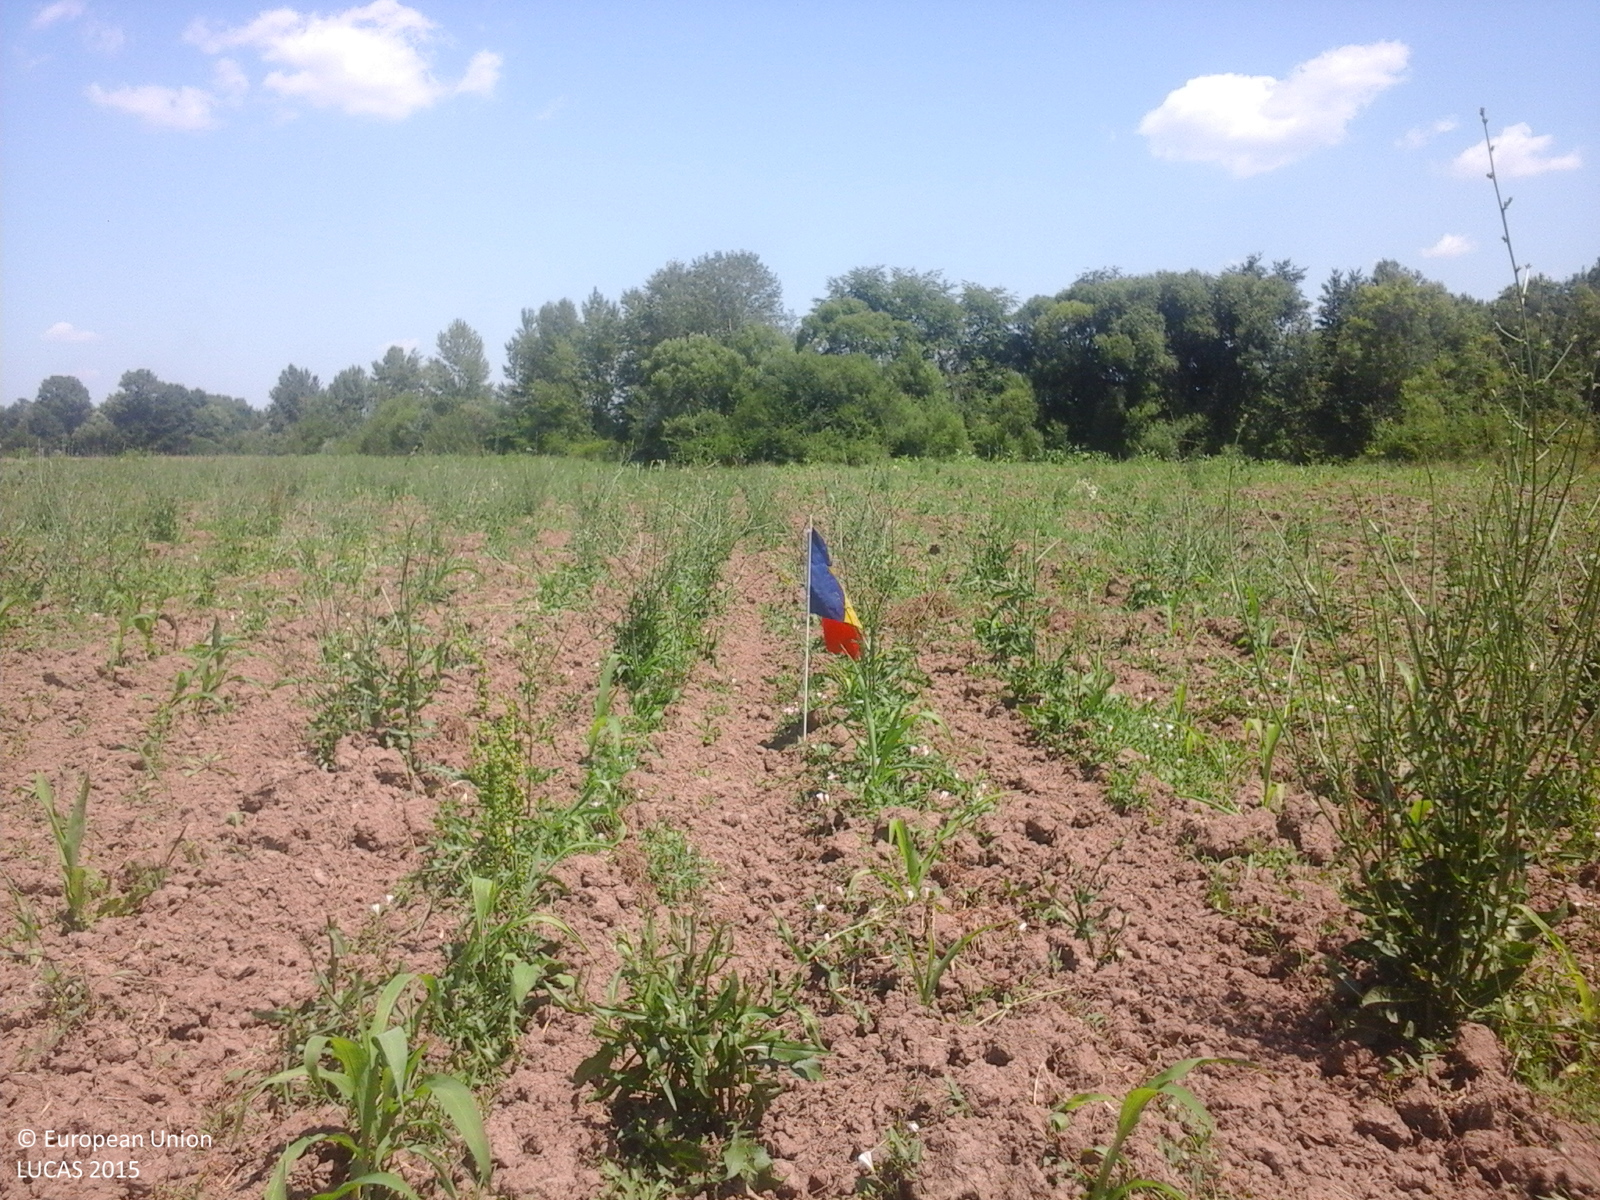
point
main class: Cropland
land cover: Maize
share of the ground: < 10 %
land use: Agriculture (excluding fallow land and kitchen gardens)
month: July
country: RO
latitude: 44.4483
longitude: 24.7140
